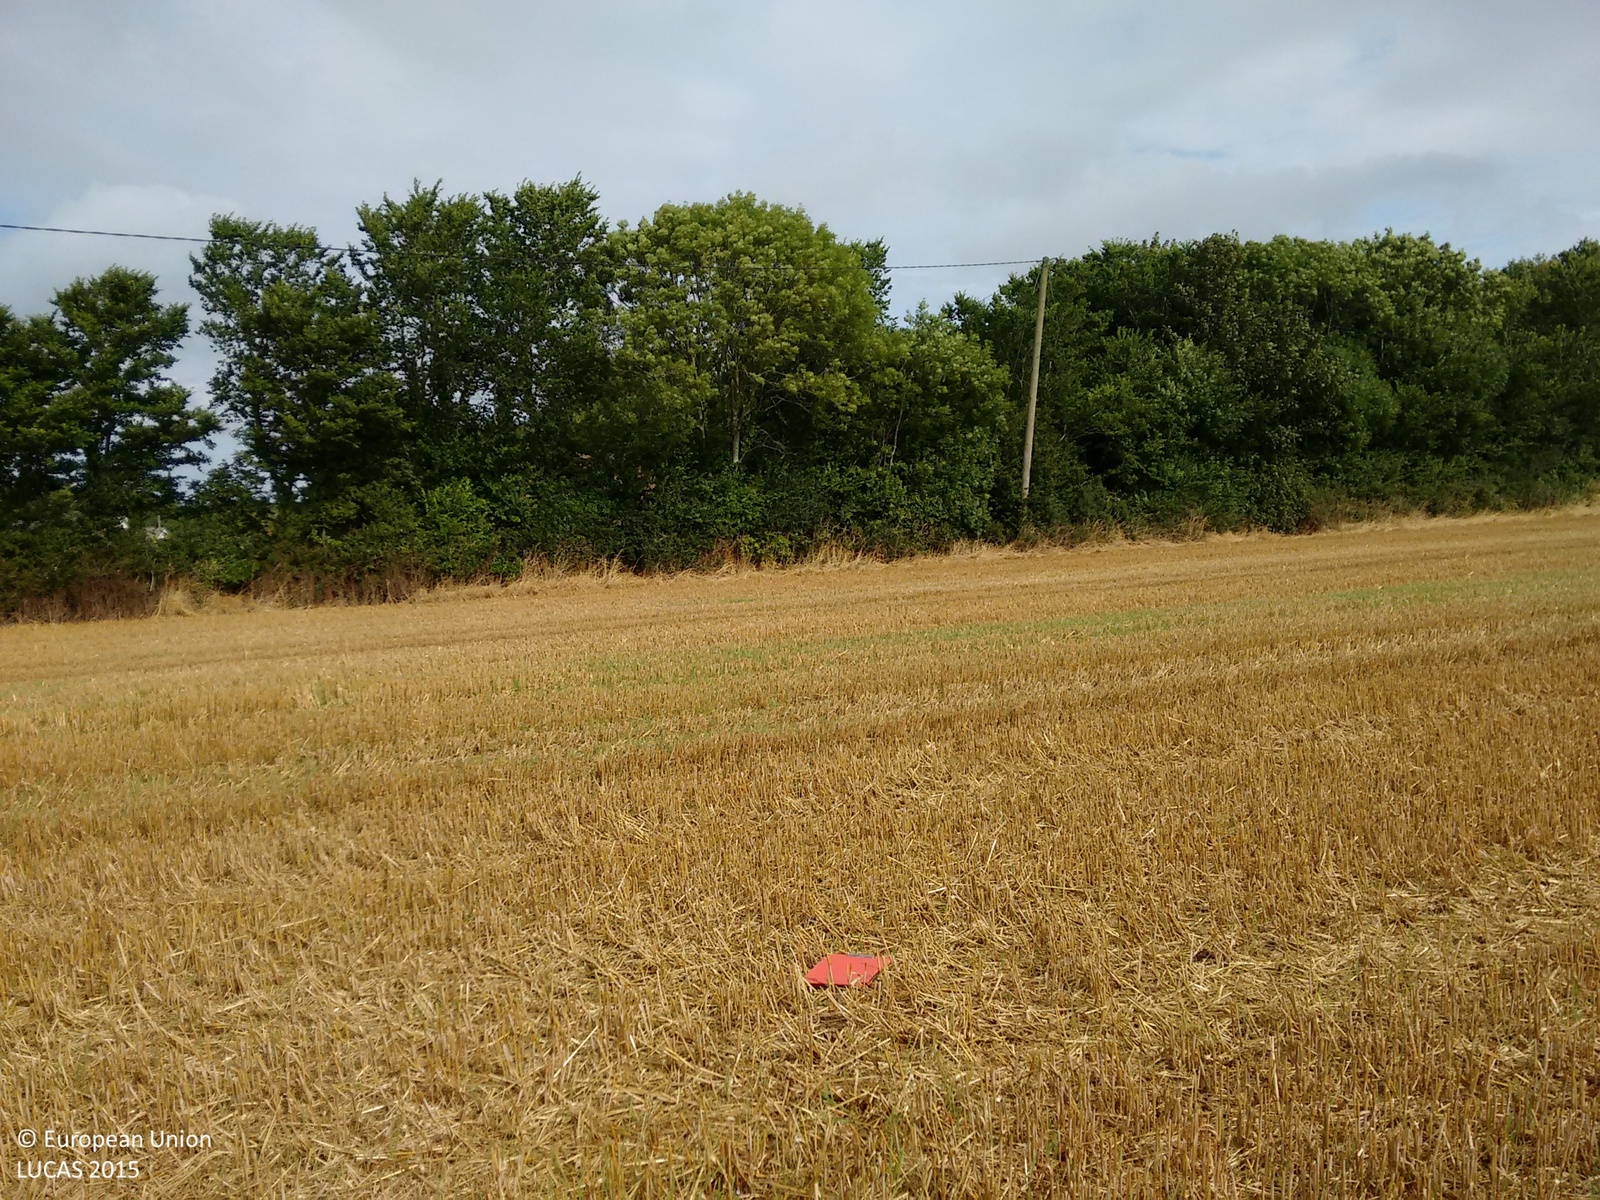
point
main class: Cropland
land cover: Oats
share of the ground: > 75 %
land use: Agriculture (excluding fallow land and kitchen gardens)
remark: Harvested field
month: August
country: IE
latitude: 52.3641
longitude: -6.5325
